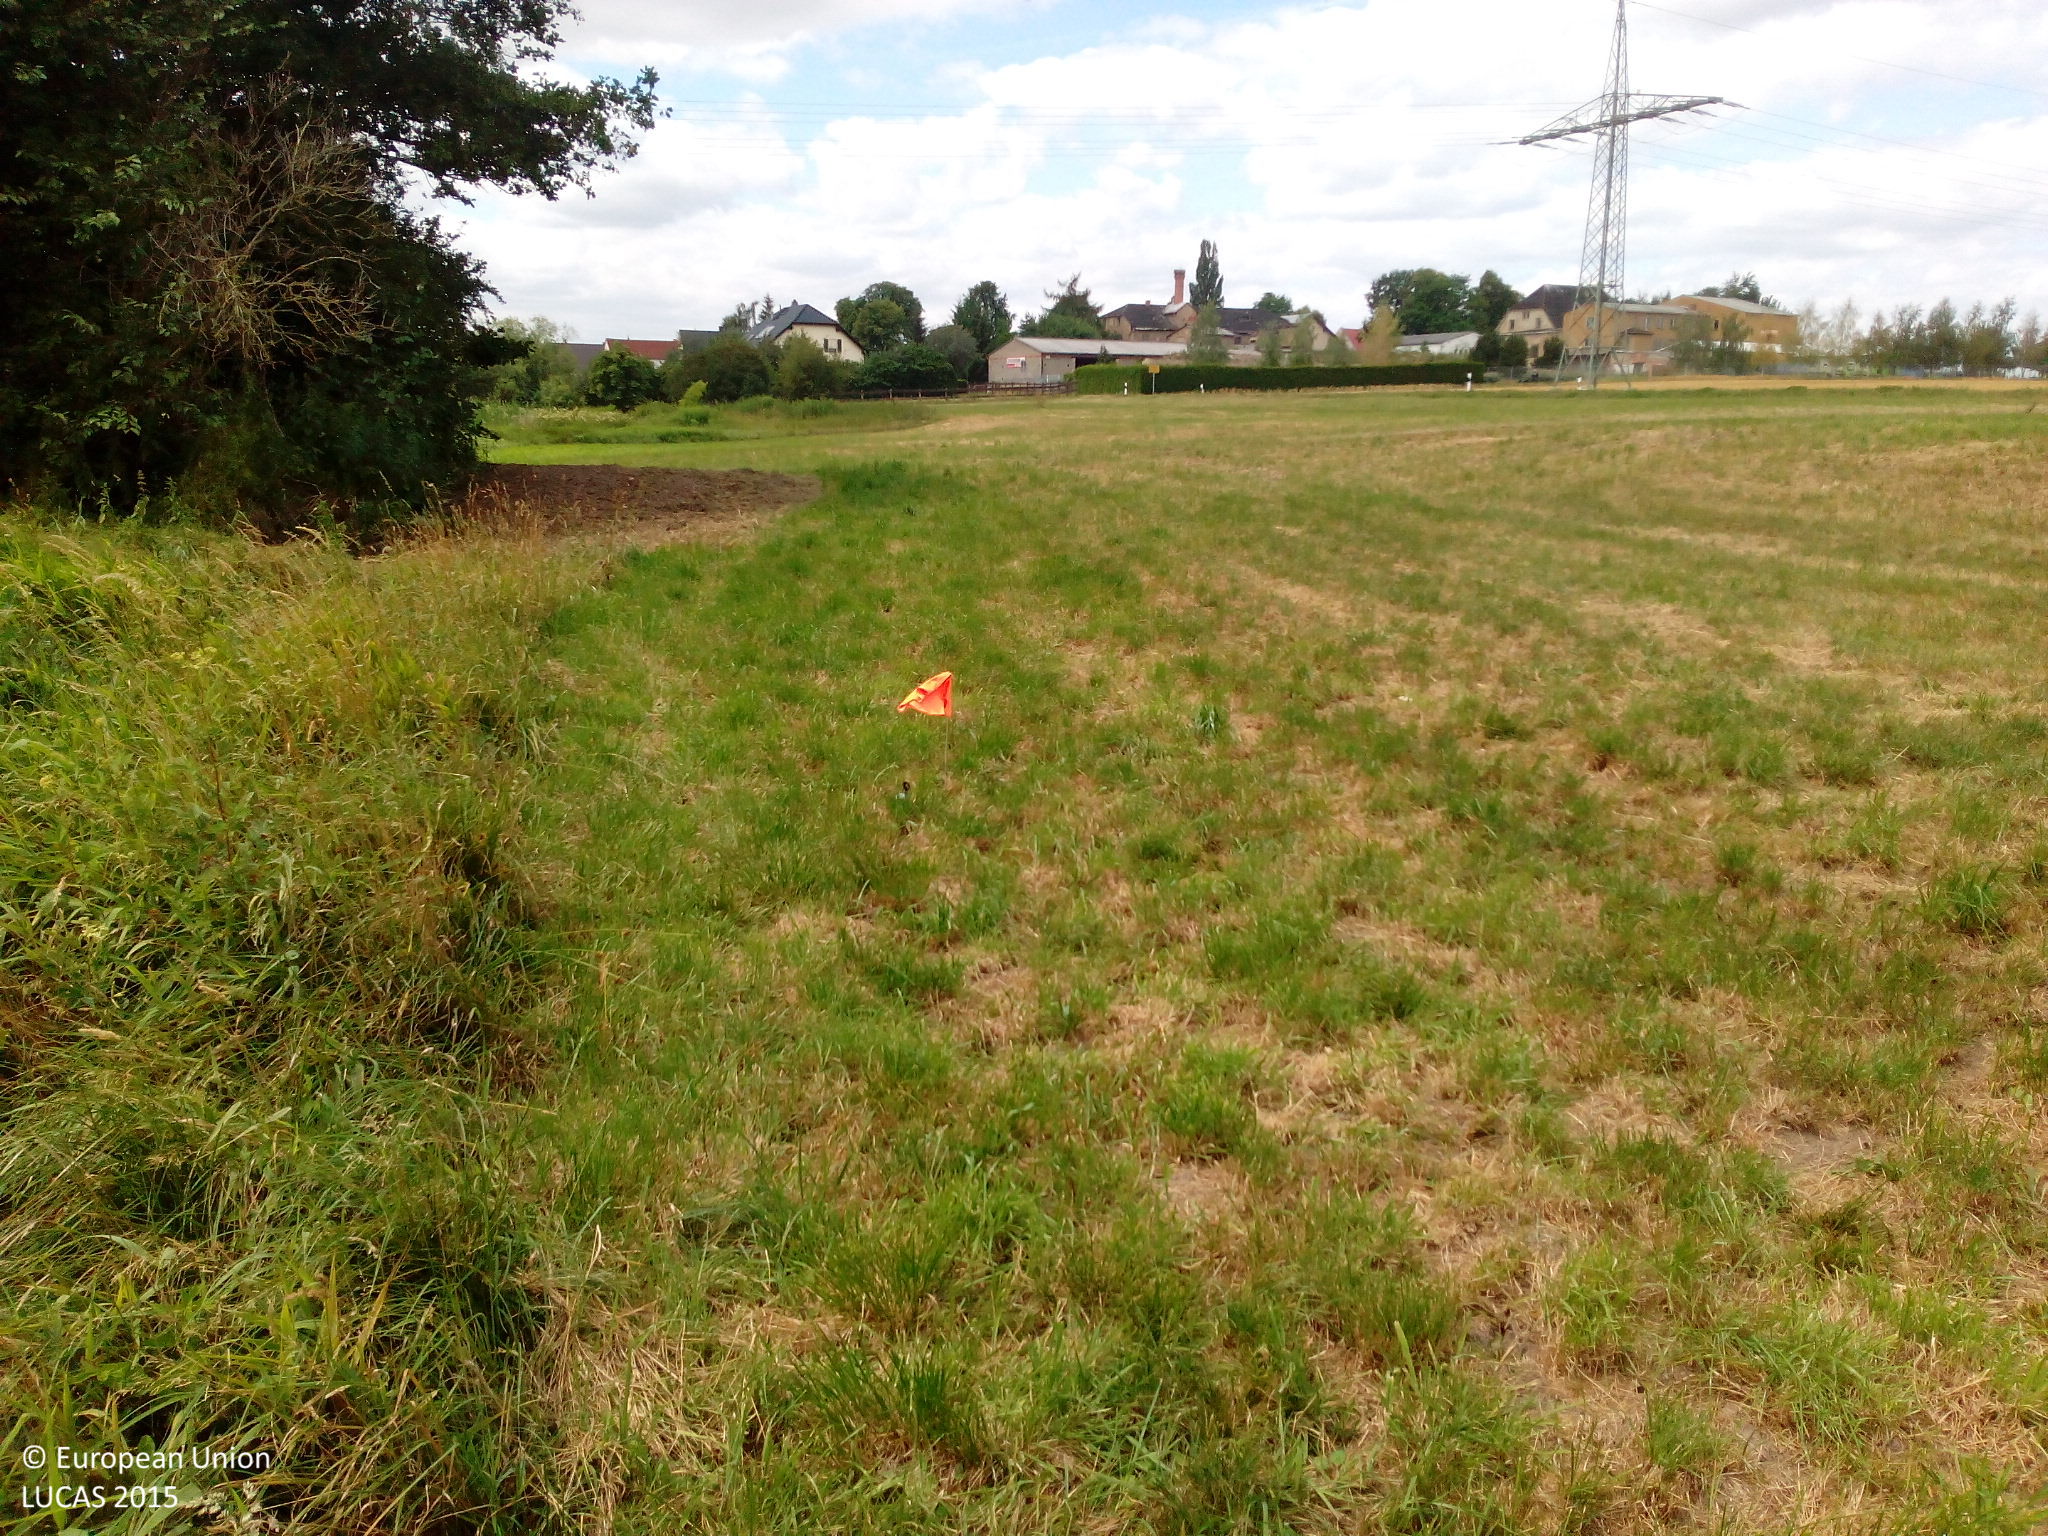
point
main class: Grassland
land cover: Grassland without tree/shrub cover
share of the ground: > 75 %
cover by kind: herbaceous plants 100 %
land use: Agriculture (excluding fallow land and kitchen gardens)
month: July
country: DE
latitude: 51.2174
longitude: 12.5339
